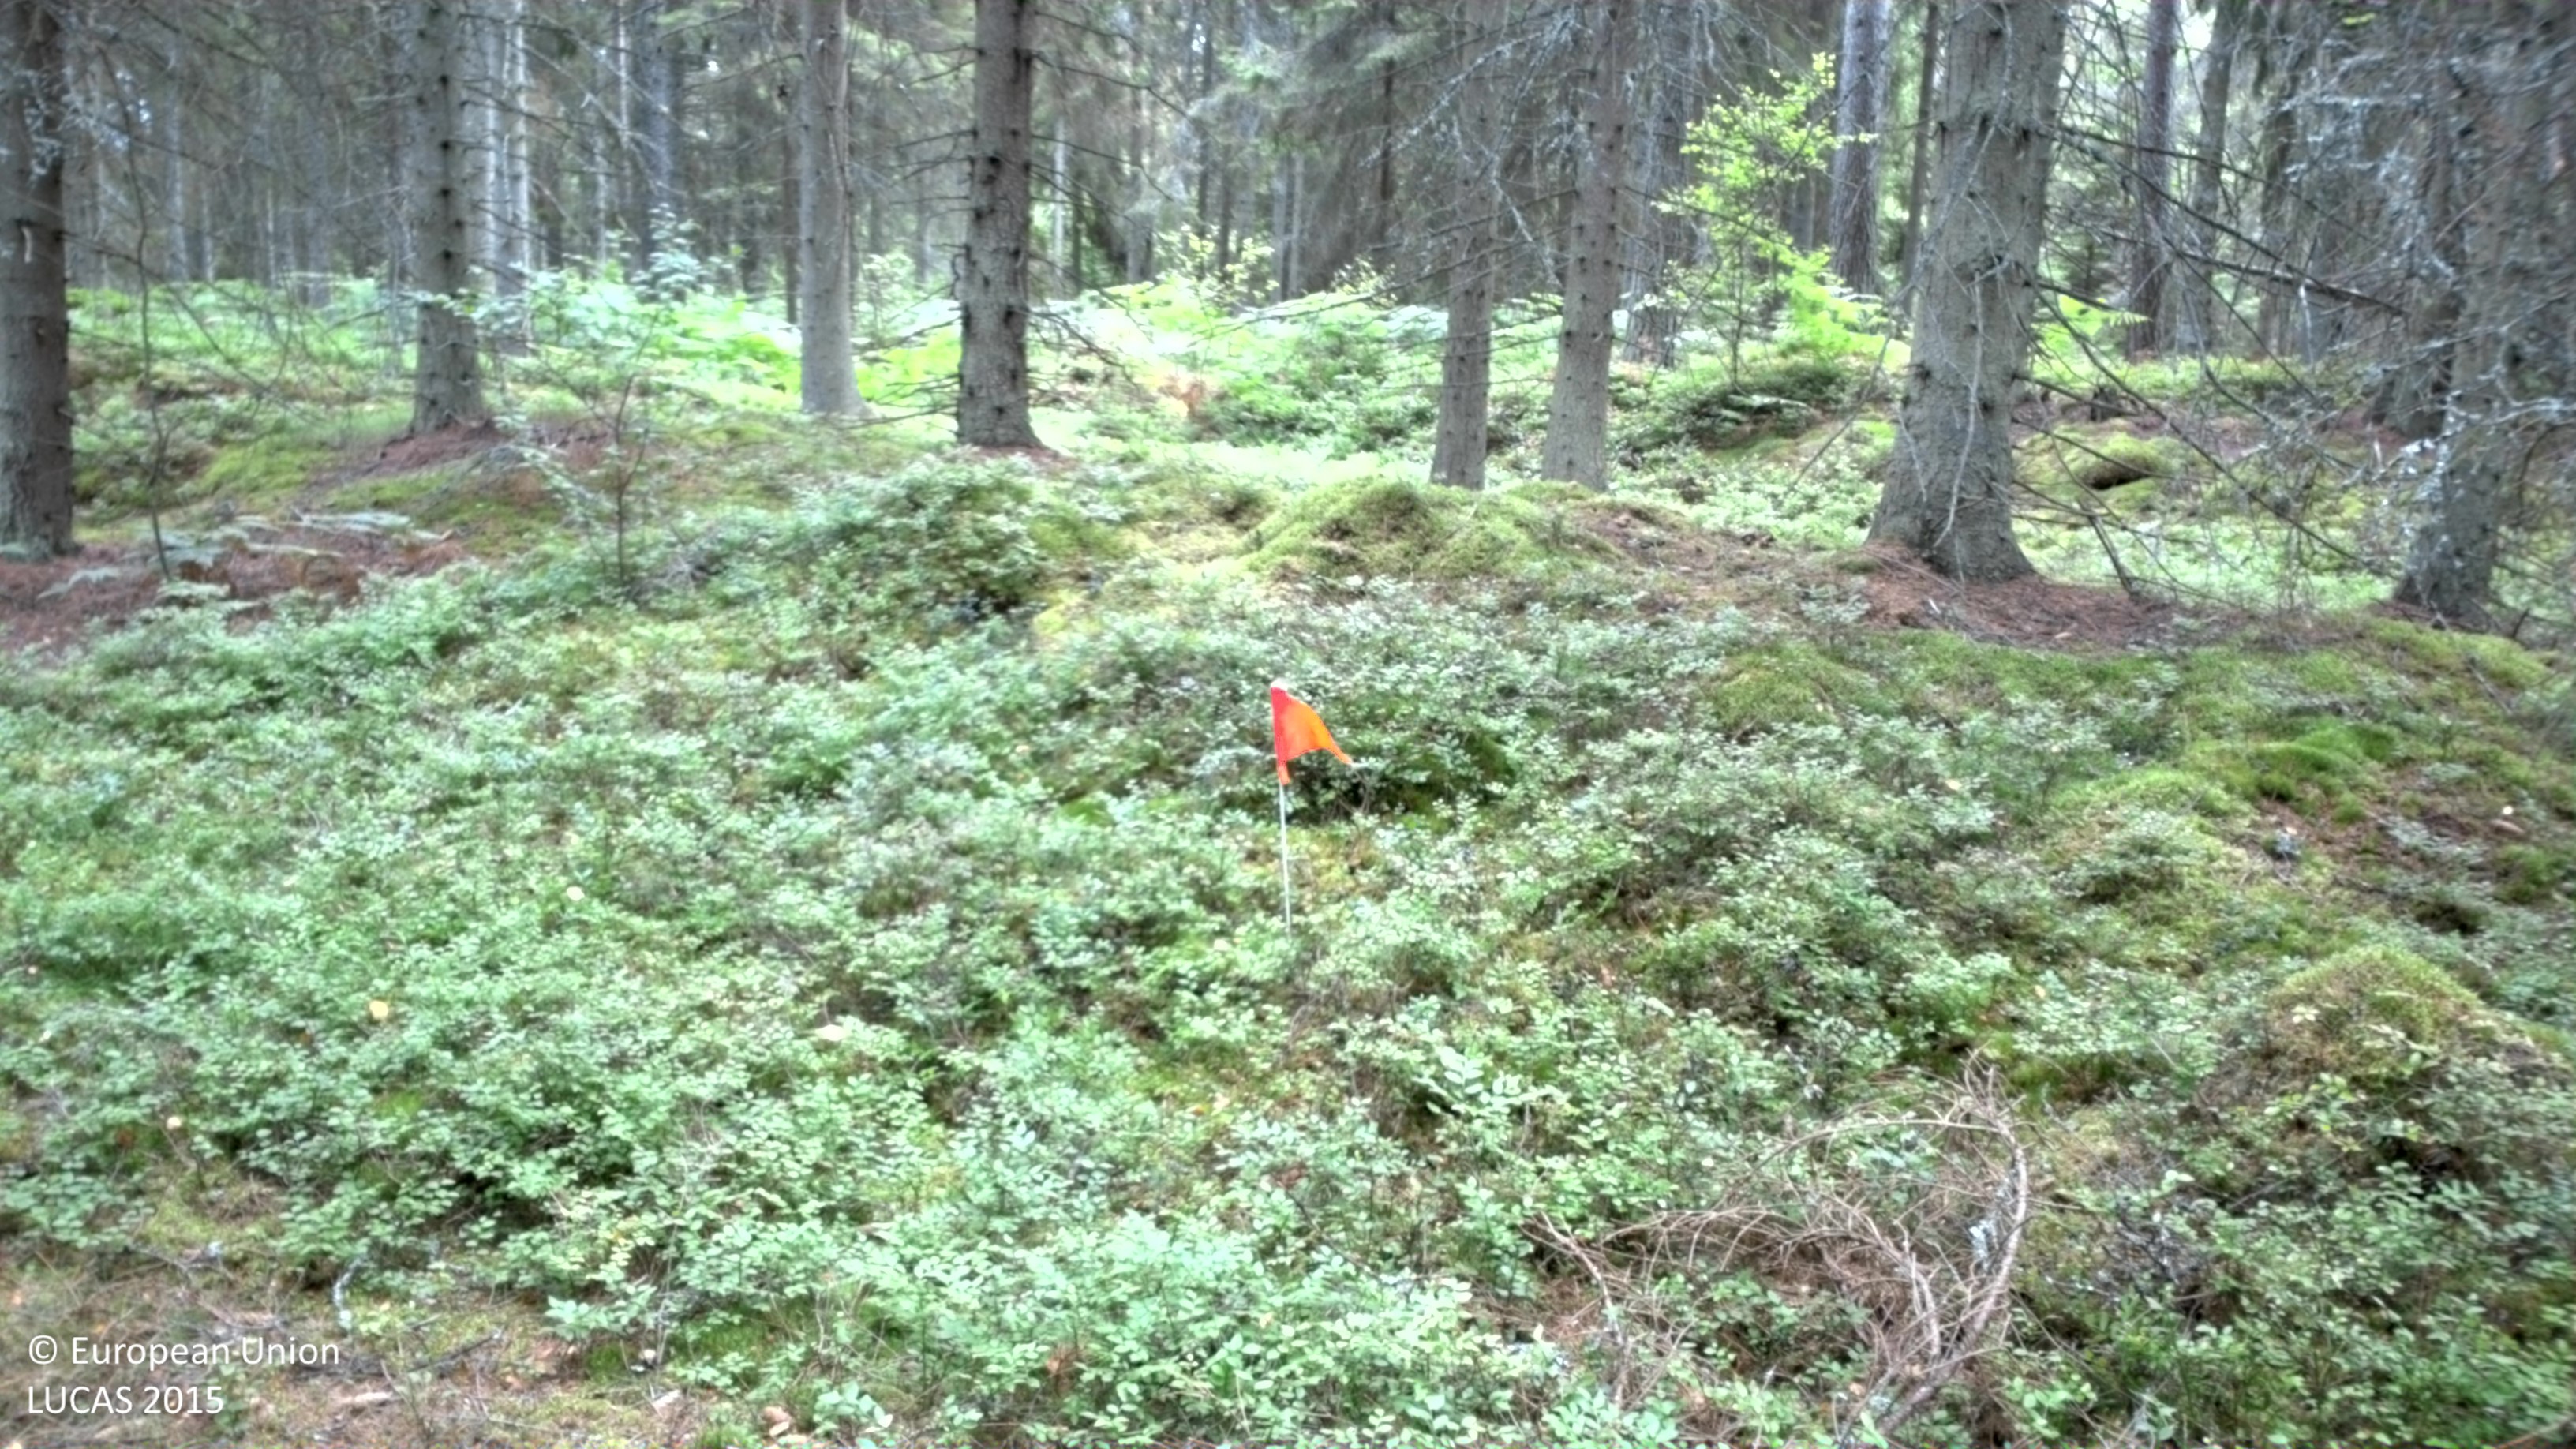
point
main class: Woodland
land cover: Spruce dominated coniferous woodland
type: boreal forest
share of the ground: > 75 %
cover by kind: coniferous forest trees 75 %, shrubs 15 %, herbaceous plants 5 %, lichens and mosses 5 %
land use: Forestry
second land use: Amenities, museums, leisure
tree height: > 5 m
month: July
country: SE
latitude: 57.2937
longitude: 17.0541
